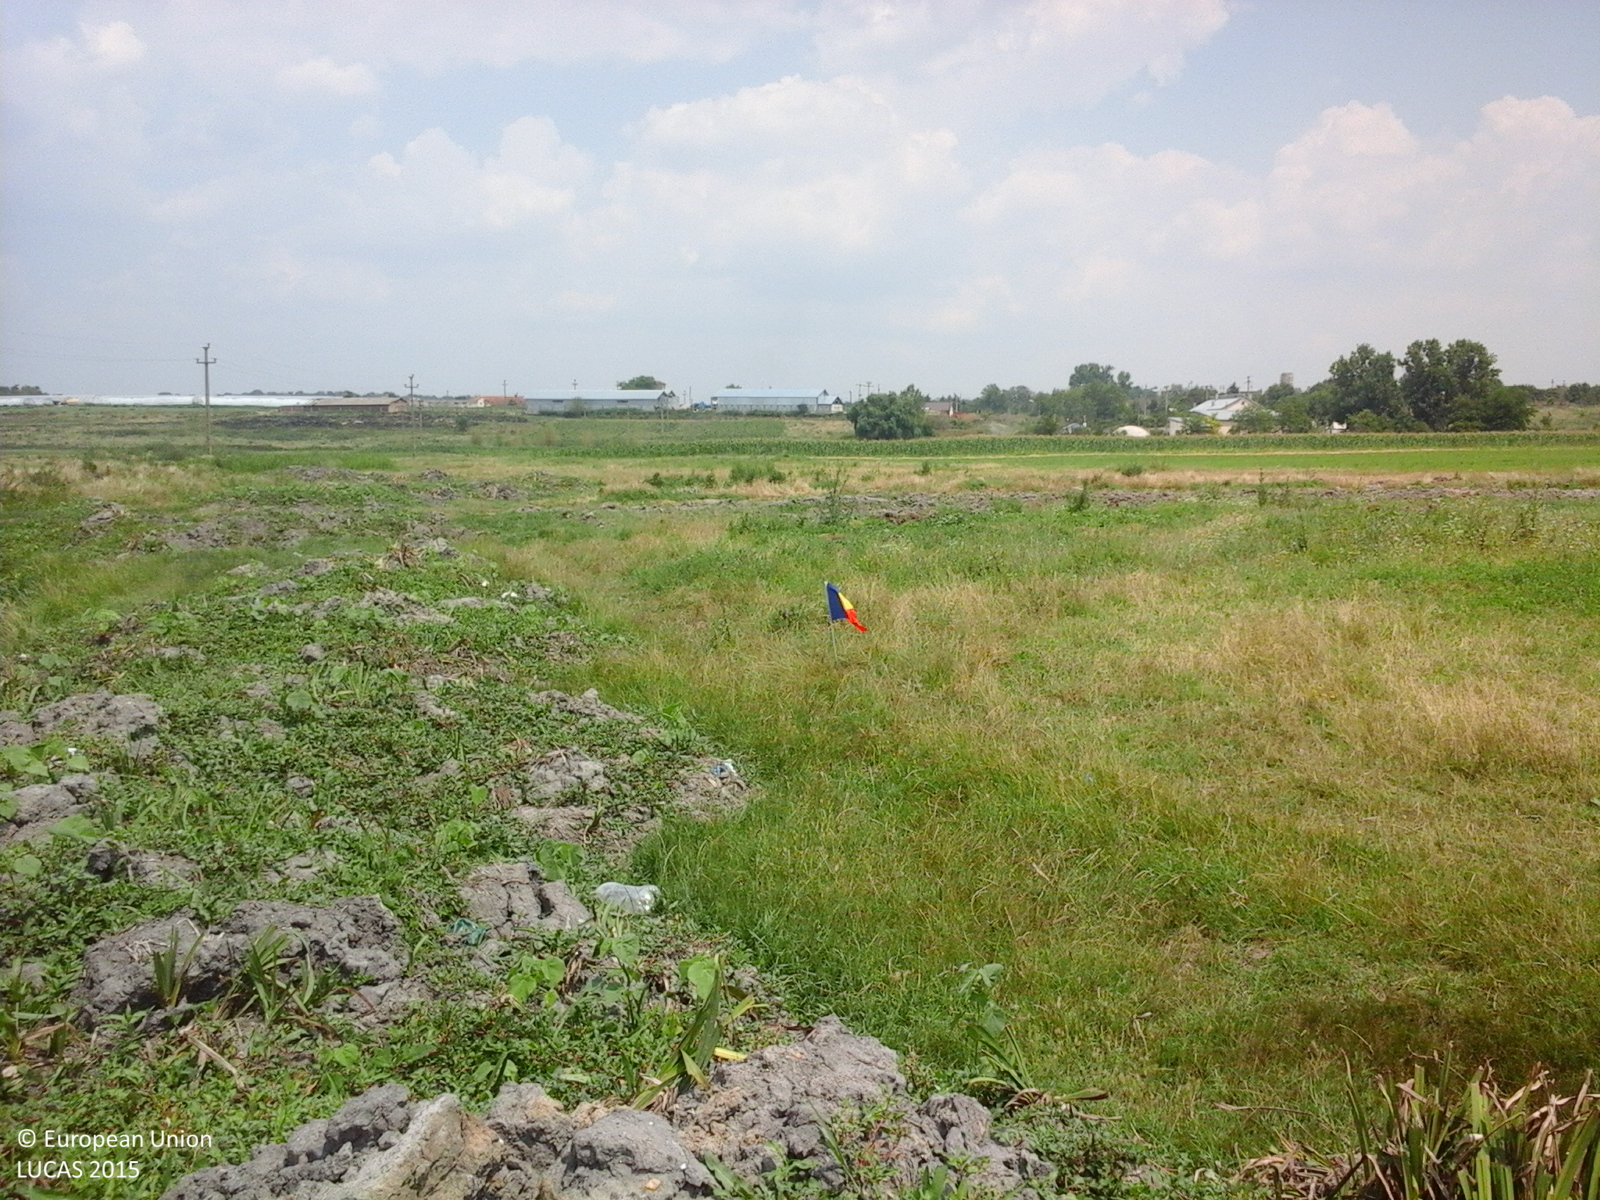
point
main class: Grassland
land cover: Grassland without tree/shrub cover
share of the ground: > 75 %
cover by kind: herbaceous plants 100 %
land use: Agriculture (excluding fallow land and kitchen gardens)
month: July
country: RO
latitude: 43.7981
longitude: 25.1535
